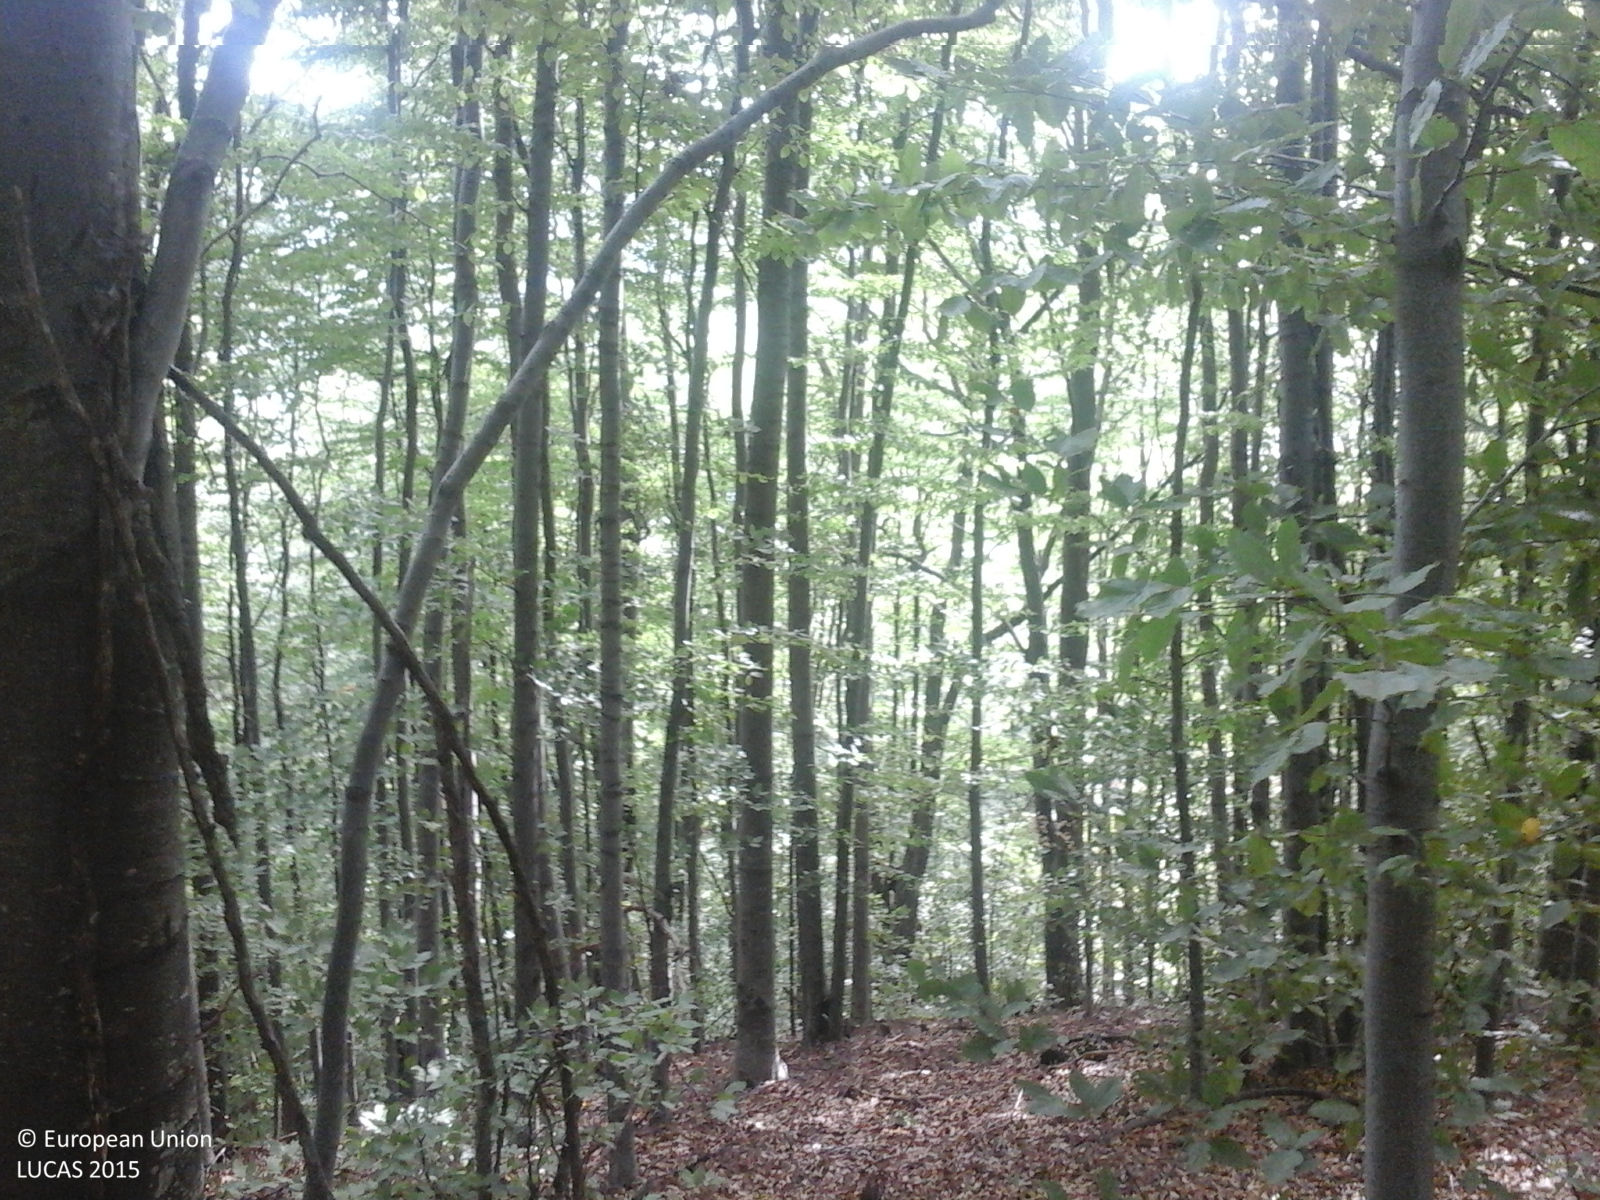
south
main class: Woodland
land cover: Broadleaved woodland
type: mesophytic deciduous forest
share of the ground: > 75 %
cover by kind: broadleaved forest trees 100 %
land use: Forestry
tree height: > 5 m
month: September
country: RO
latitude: 47.3756
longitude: 24.0290
